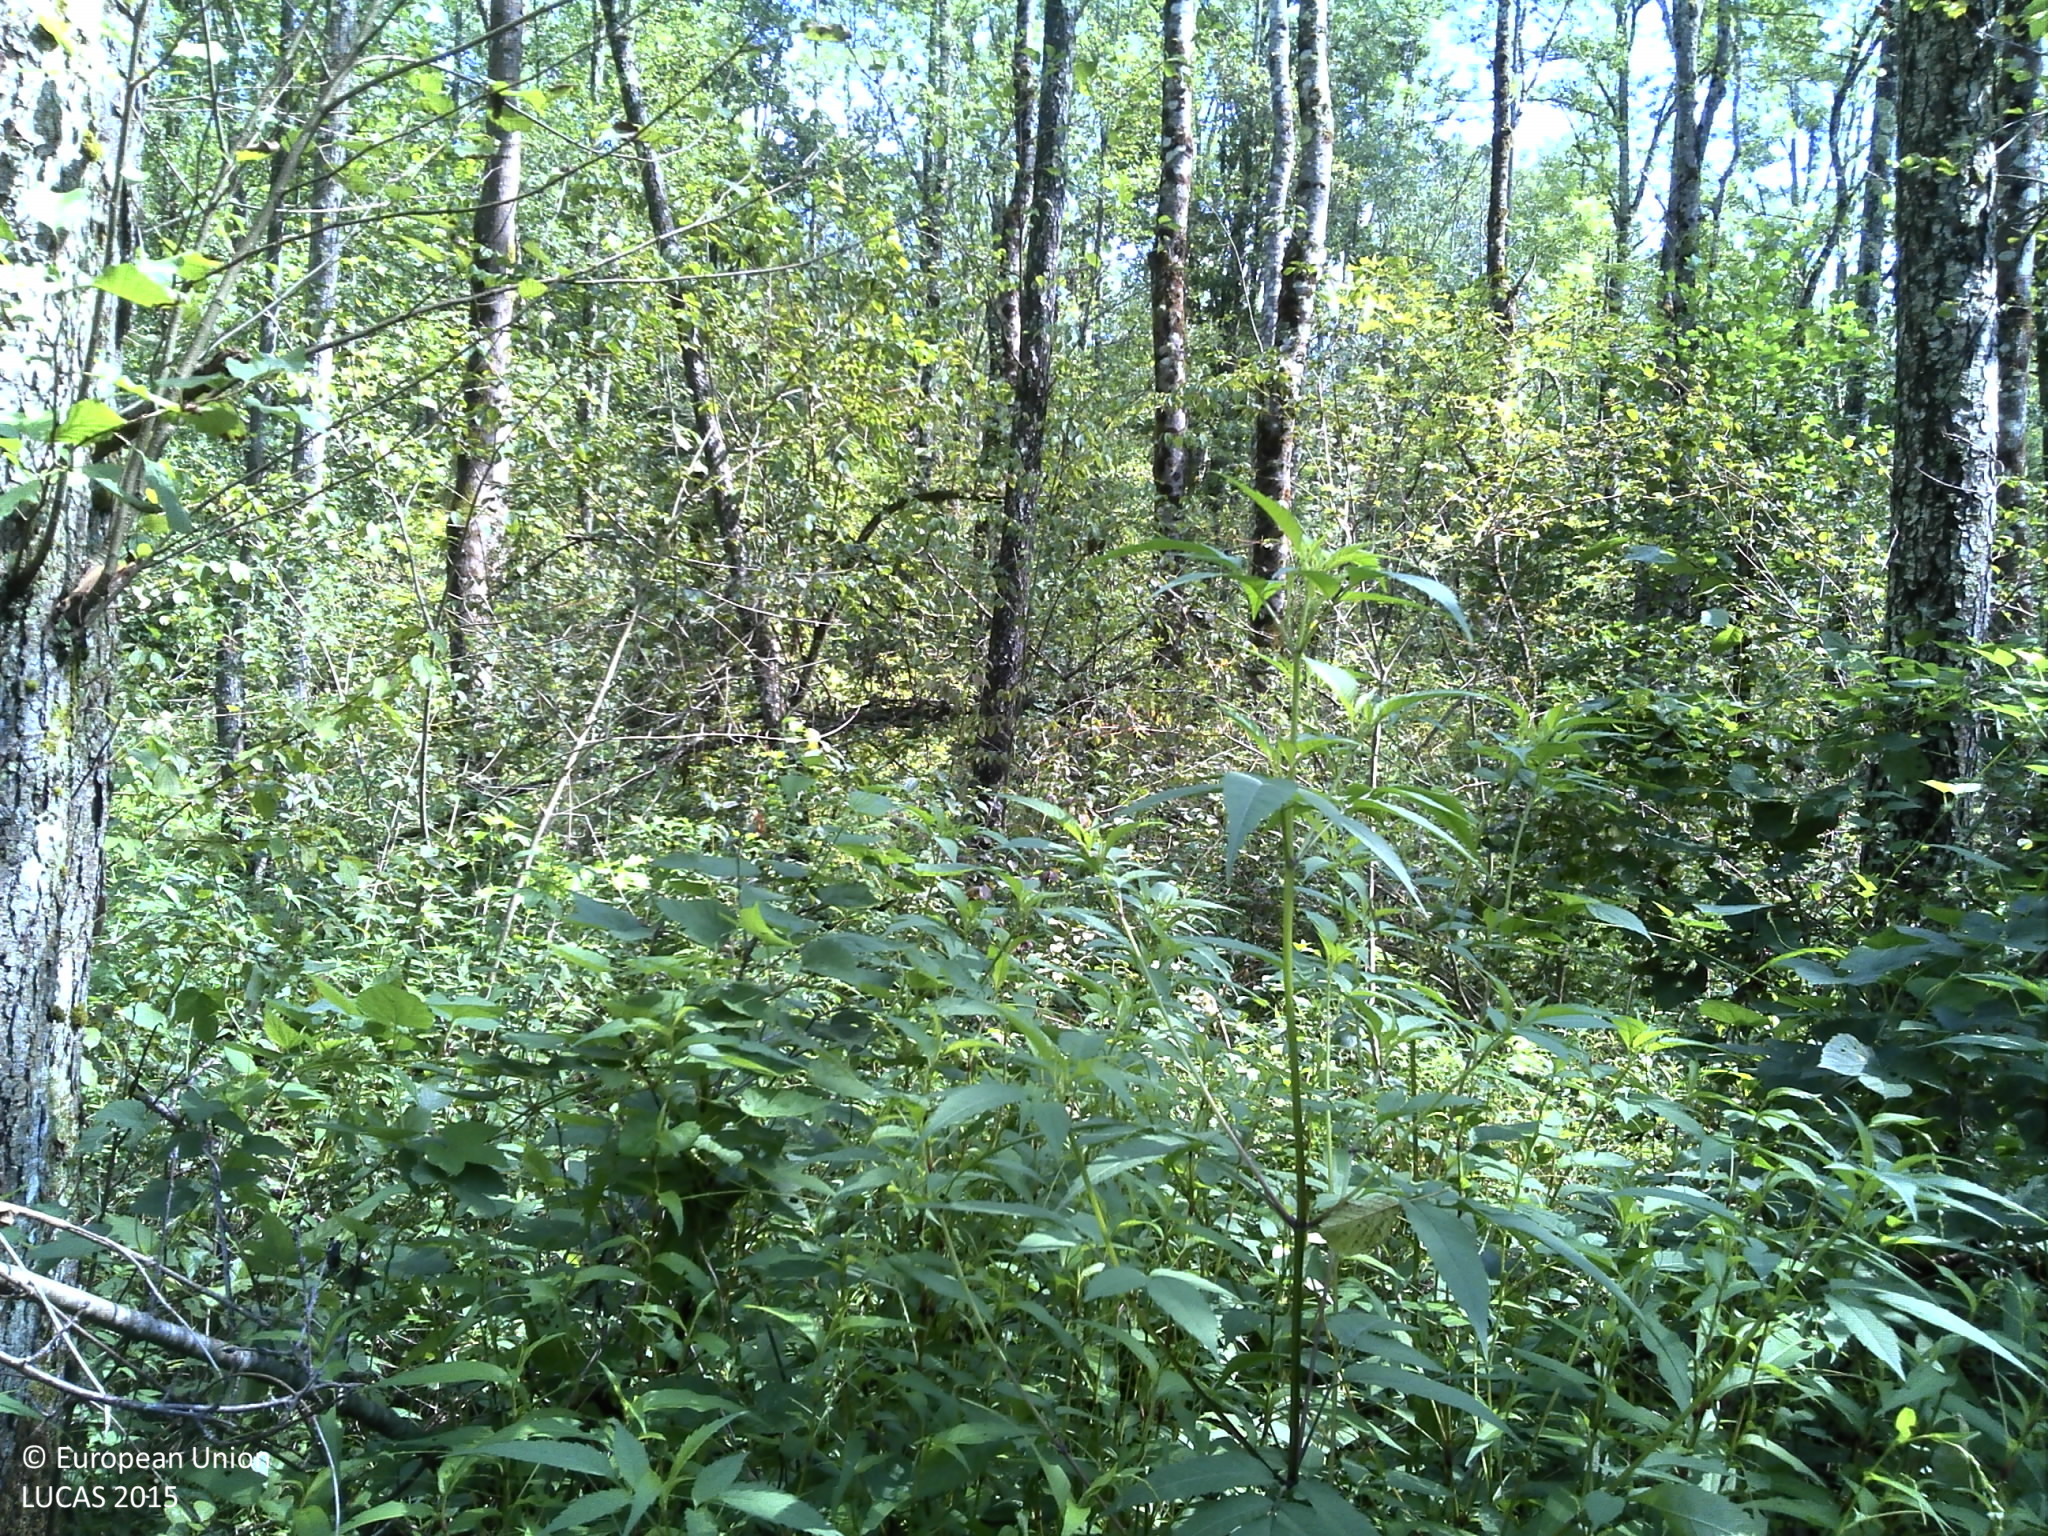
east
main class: Woodland
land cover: Broadleaved woodland
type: mesophytic deciduous forest
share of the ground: > 75 %
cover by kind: broadleaved forest trees 100 %
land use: Forestry
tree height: > 5 m
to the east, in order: Broadleaved woodland; Ditches and canals; Spontaneously vegetated surfaces; Paved roads, cycling and walking lanes; Spontaneously vegetated surfaces
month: August
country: HR
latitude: 45.5838
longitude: 15.7258
